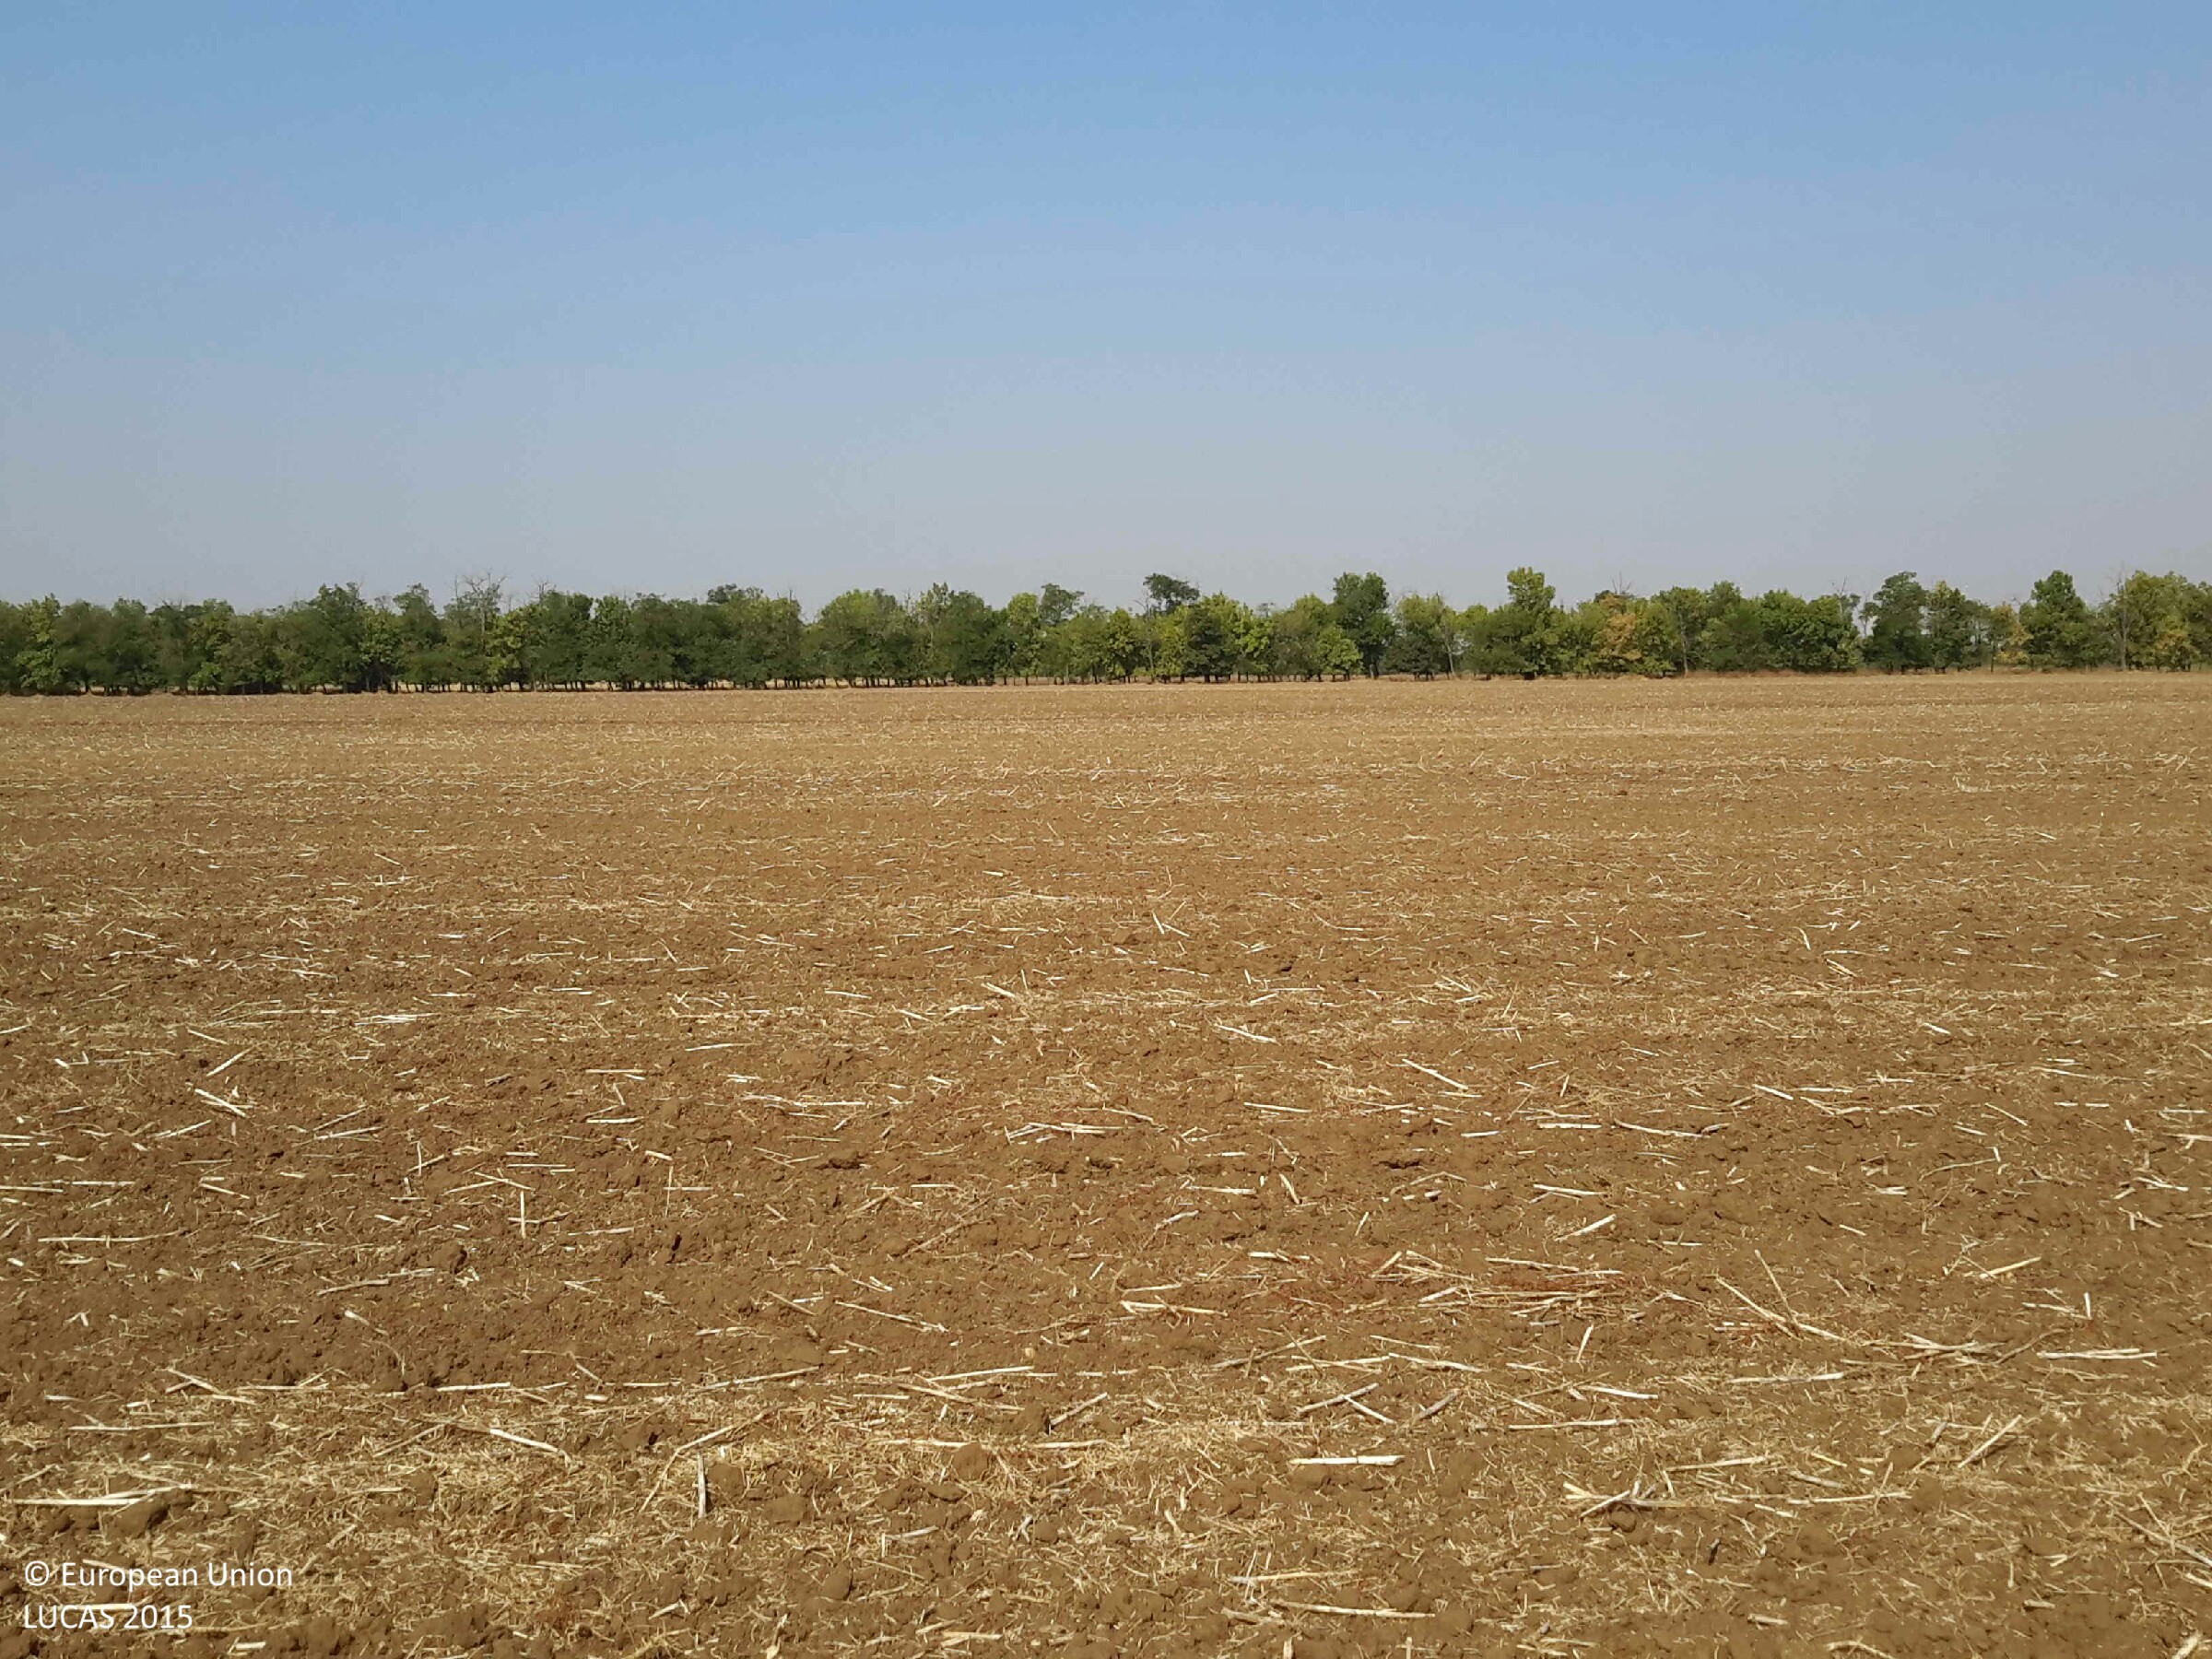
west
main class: Cropland
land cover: Rape and turnip rape
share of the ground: < 10 %
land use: Agriculture (excluding fallow land and kitchen gardens)
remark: Harvested field
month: August
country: HU
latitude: 47.8659
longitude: 17.1325
